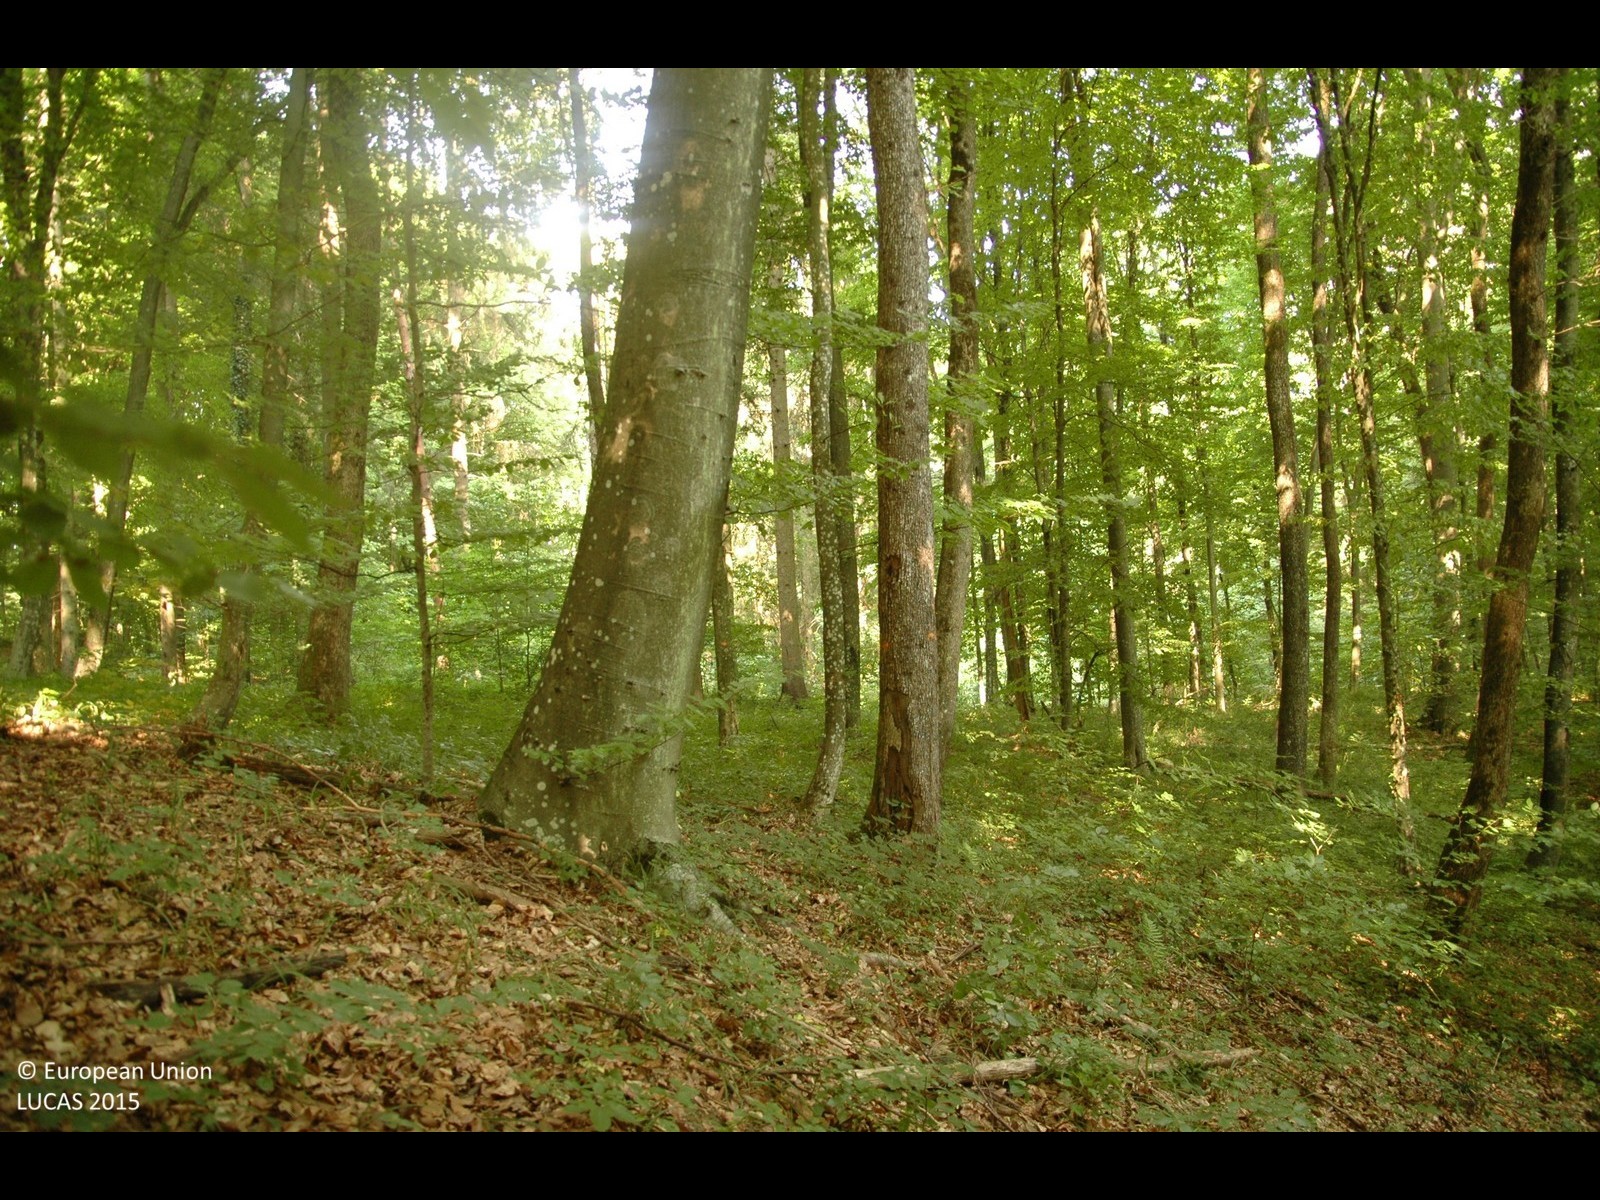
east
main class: Woodland
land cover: Broadleaved woodland
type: beech forest
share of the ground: > 75 %
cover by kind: broadleaved forest trees 100 %
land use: Forestry
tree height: > 5 m
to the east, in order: Broadleaved woodland; Rivers and streams; Tracks; Broadleaved woodland; Rivers and streams; Broadleaved woodland
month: July
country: HR
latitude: 46.1511
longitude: 16.5389
